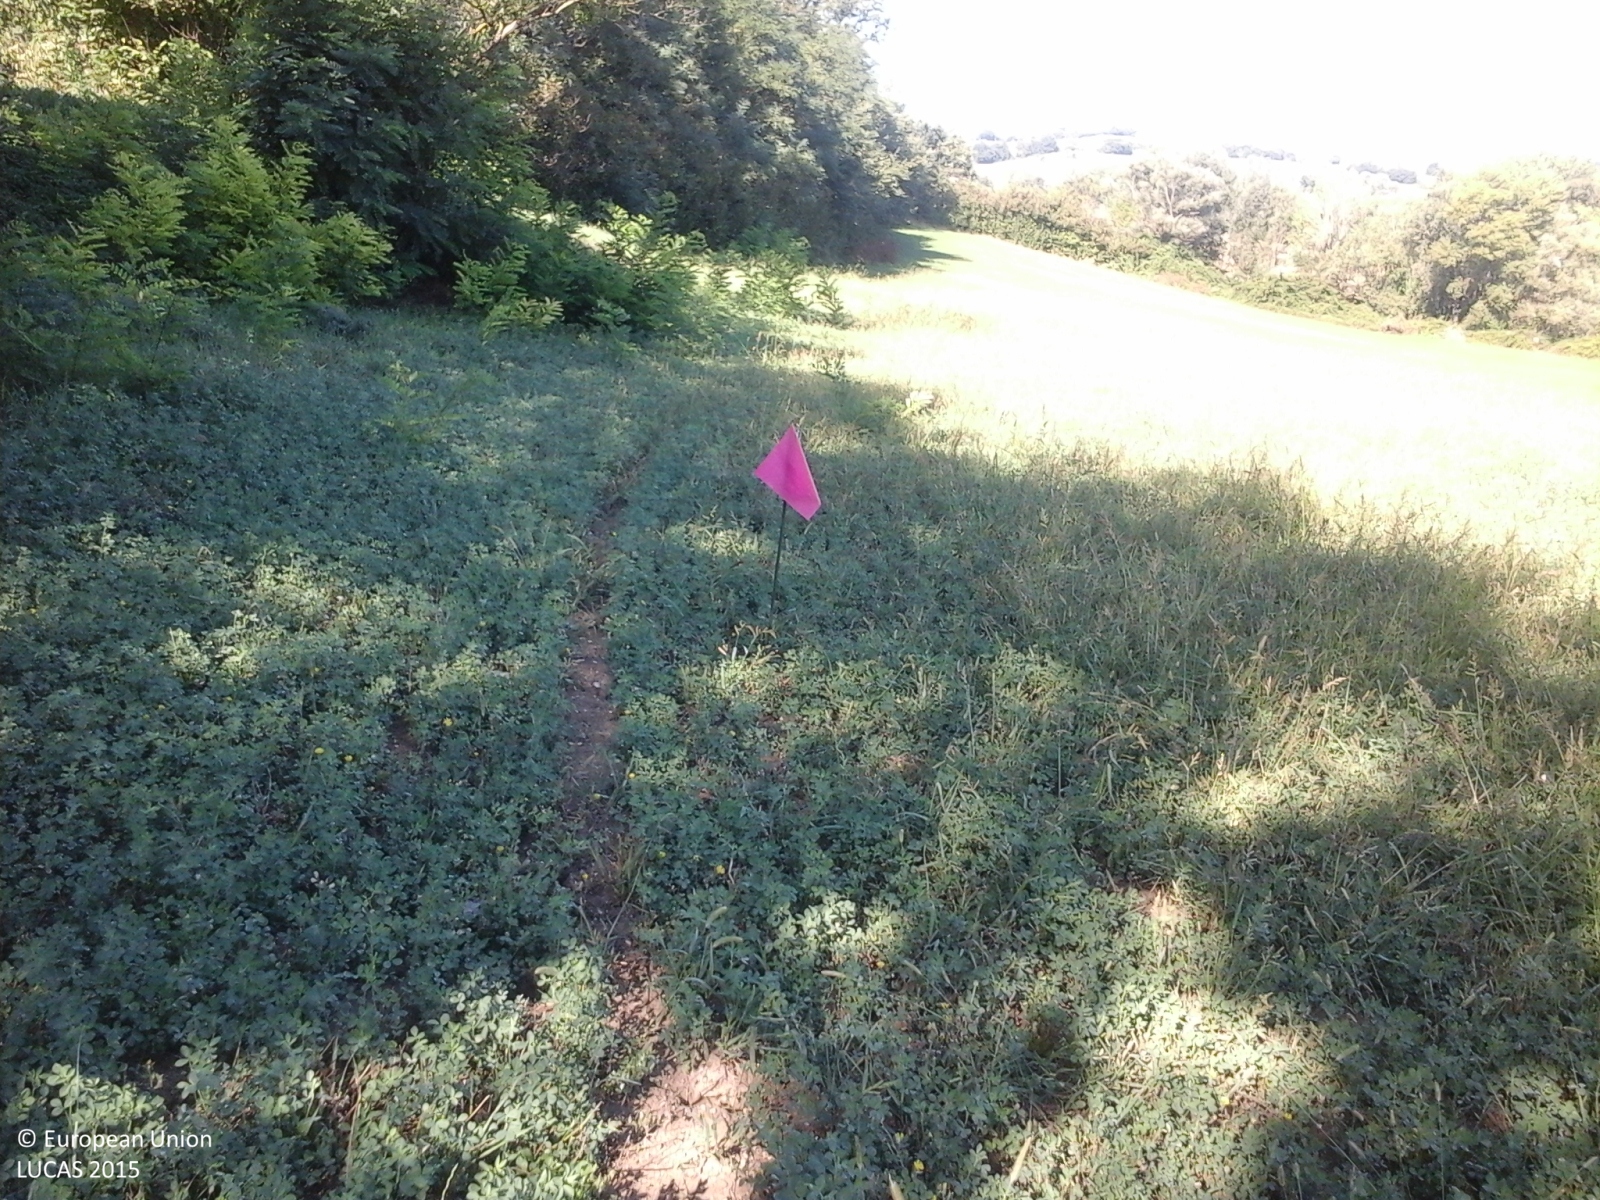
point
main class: Cropland
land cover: Lucerne
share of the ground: > 75 %
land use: Agriculture (excluding fallow land and kitchen gardens)
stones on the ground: < 10 %
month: September
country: IT
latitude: 43.6707
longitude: 13.1551
